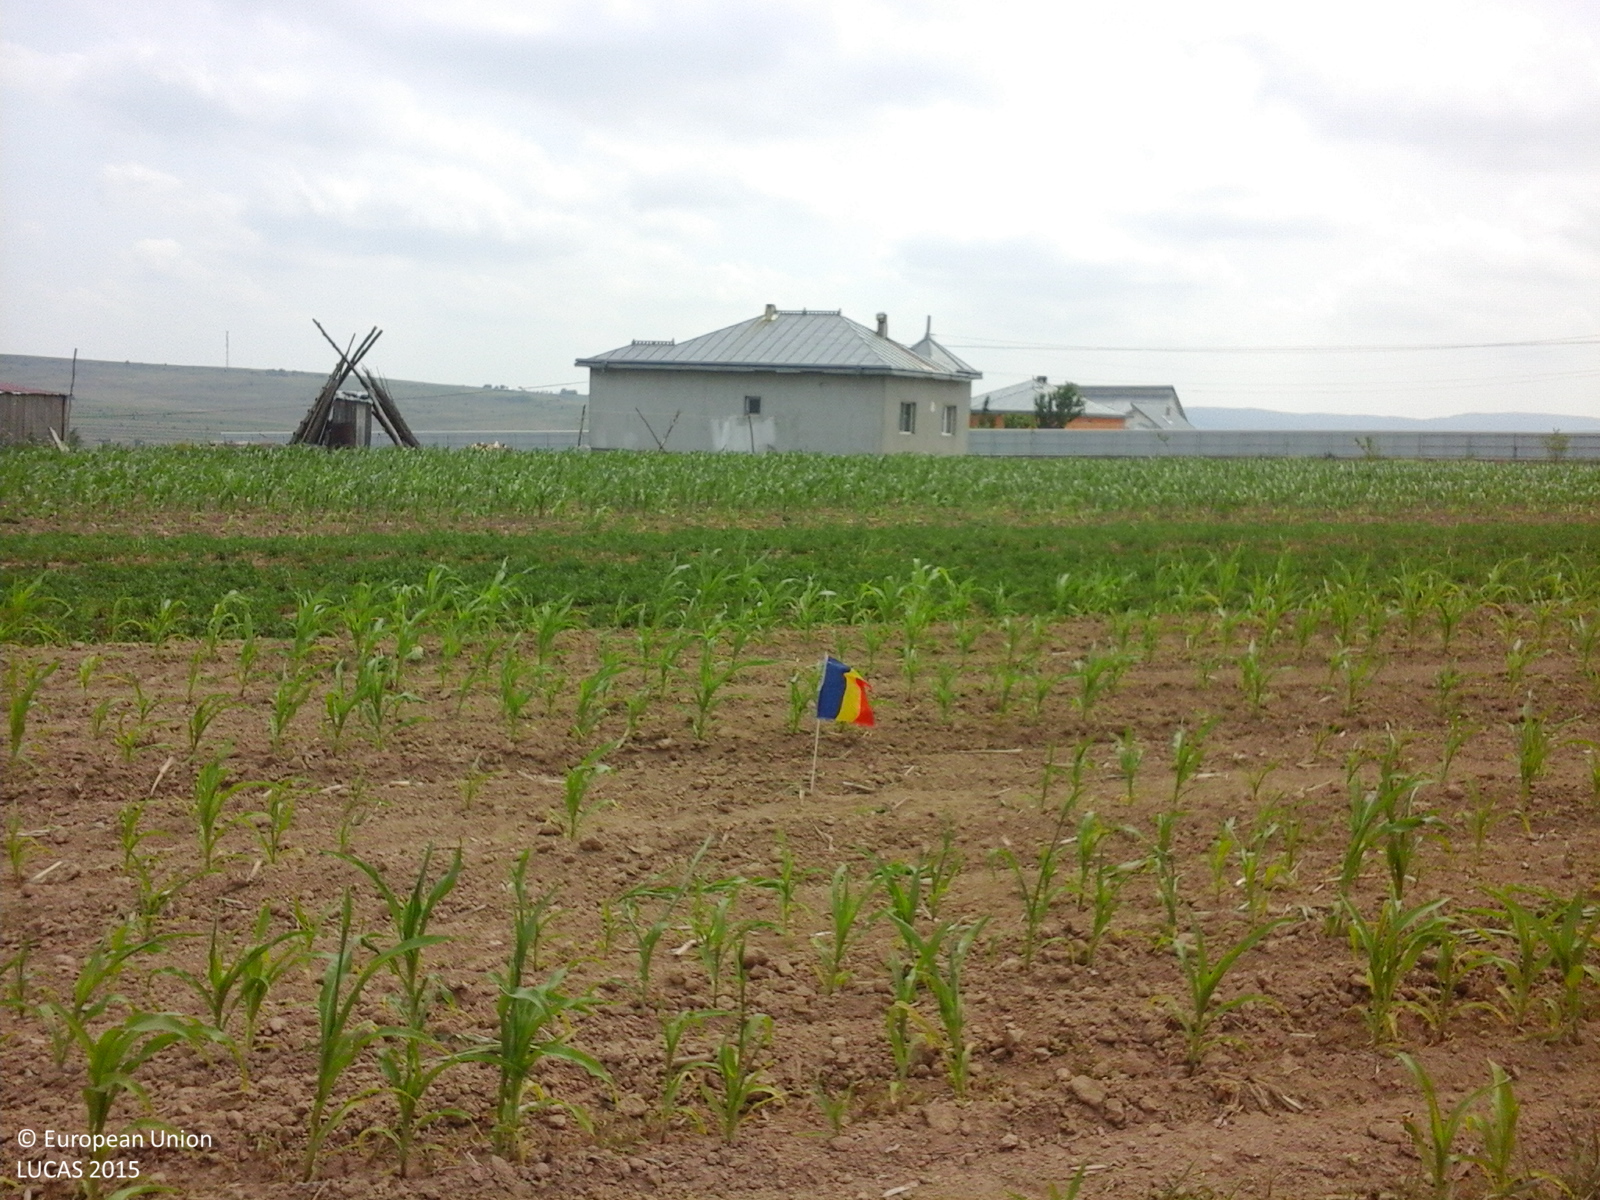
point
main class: Cropland
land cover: Maize
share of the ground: 10 - 25 %
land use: Agriculture (excluding fallow land and kitchen gardens)
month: June
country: RO
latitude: 47.5966
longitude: 26.5970
